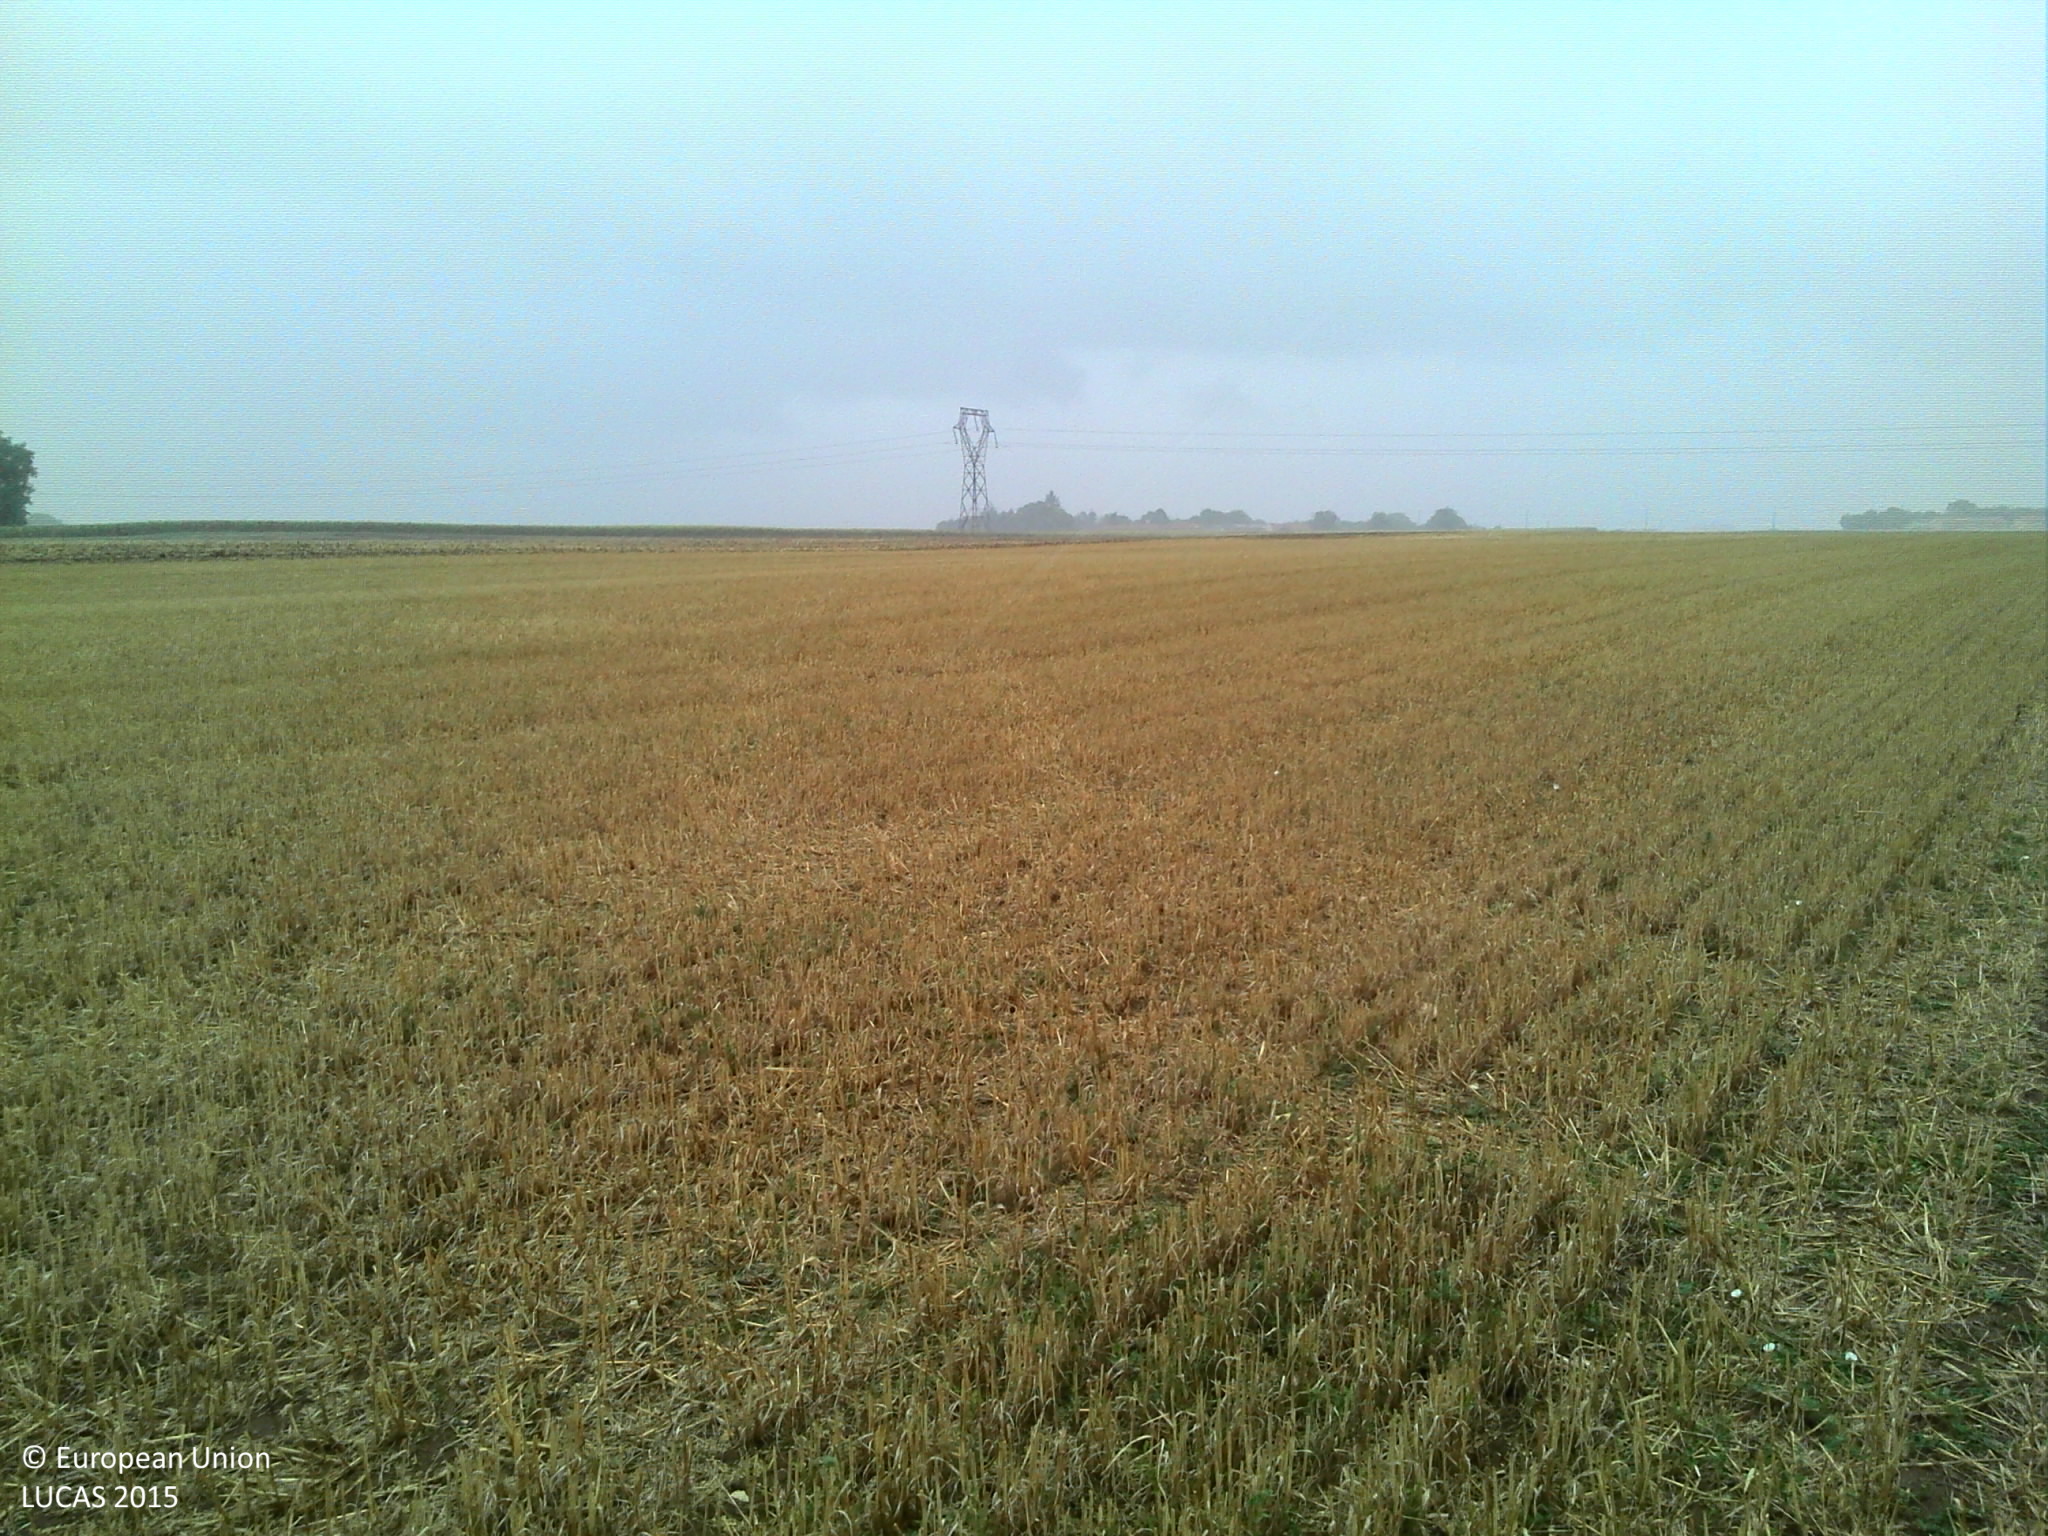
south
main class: Cropland
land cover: Common wheat
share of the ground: < 10 %
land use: Agriculture (excluding fallow land and kitchen gardens)
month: August
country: FR
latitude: 46.7478
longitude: 0.1481
